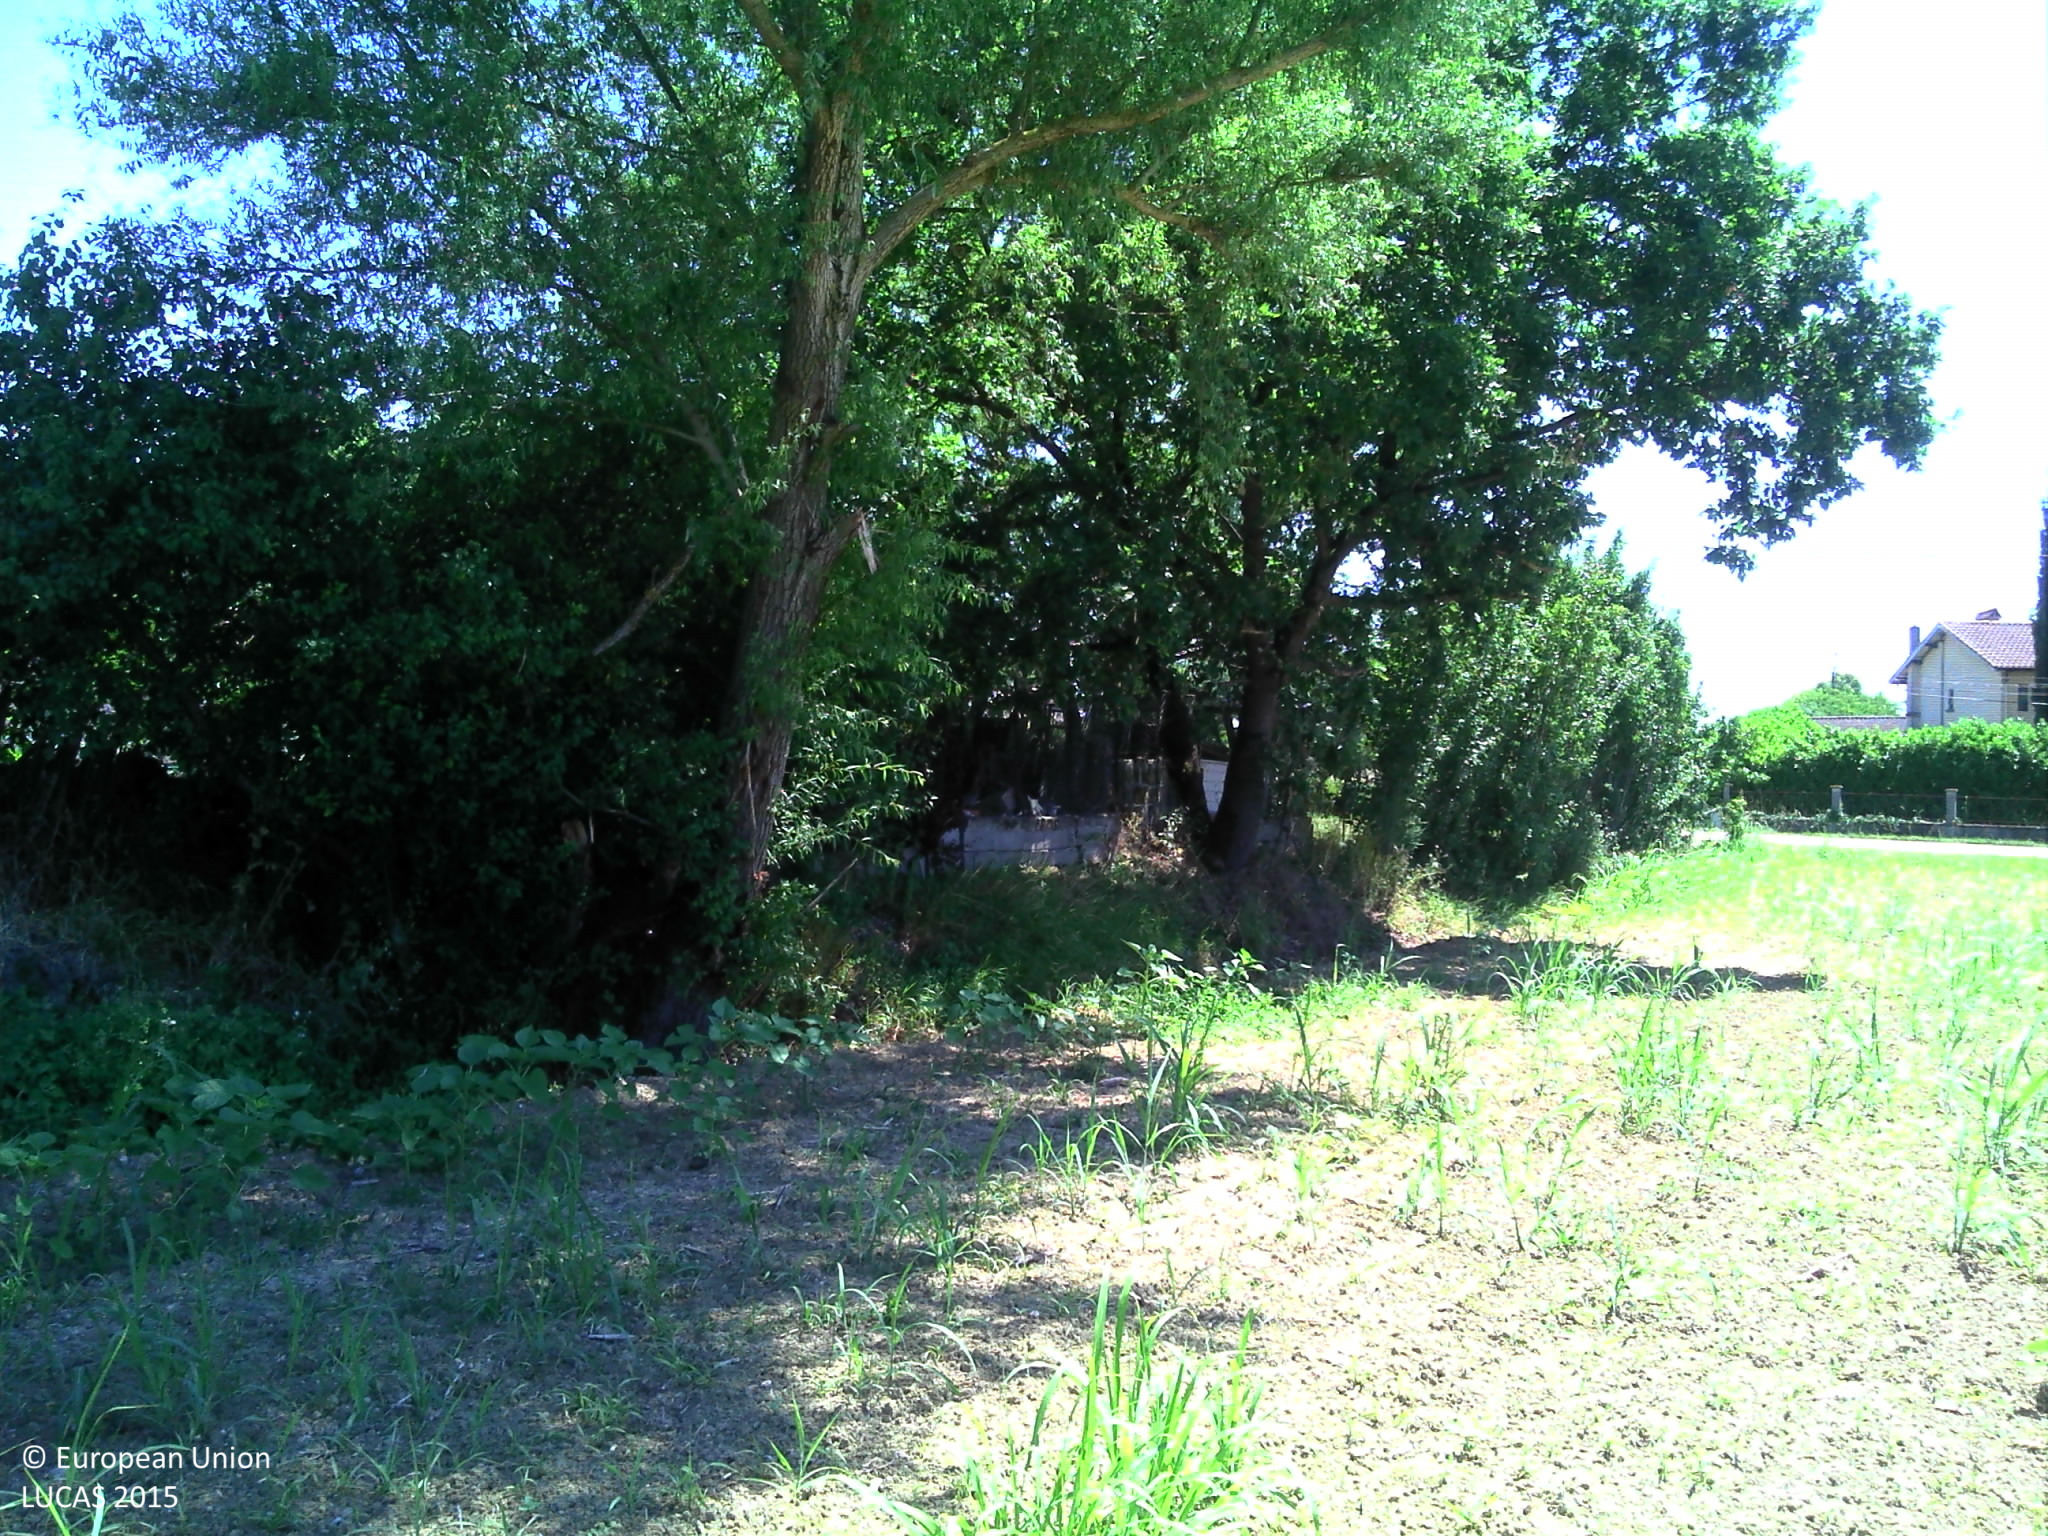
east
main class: Grassland
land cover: Spontaneously vegetated surfaces
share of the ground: 50 - 75 %
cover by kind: herbaceous plants 55 %, unconsolidated bare surface 45 %
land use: Agriculture (excluding fallow land and kitchen gardens)
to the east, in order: Spontaneously vegetated surfaces; Broadleaved woodland; Artificial constructions in urban areas; Grassland without tree/shrub cover; Single bushes/trees; Grassland without tree/shrub cover; Artificial constructions in urban areas; Lines of trees; Ditches and canals; Sunflower
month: June
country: FR
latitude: 43.7747
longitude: 1.3916
